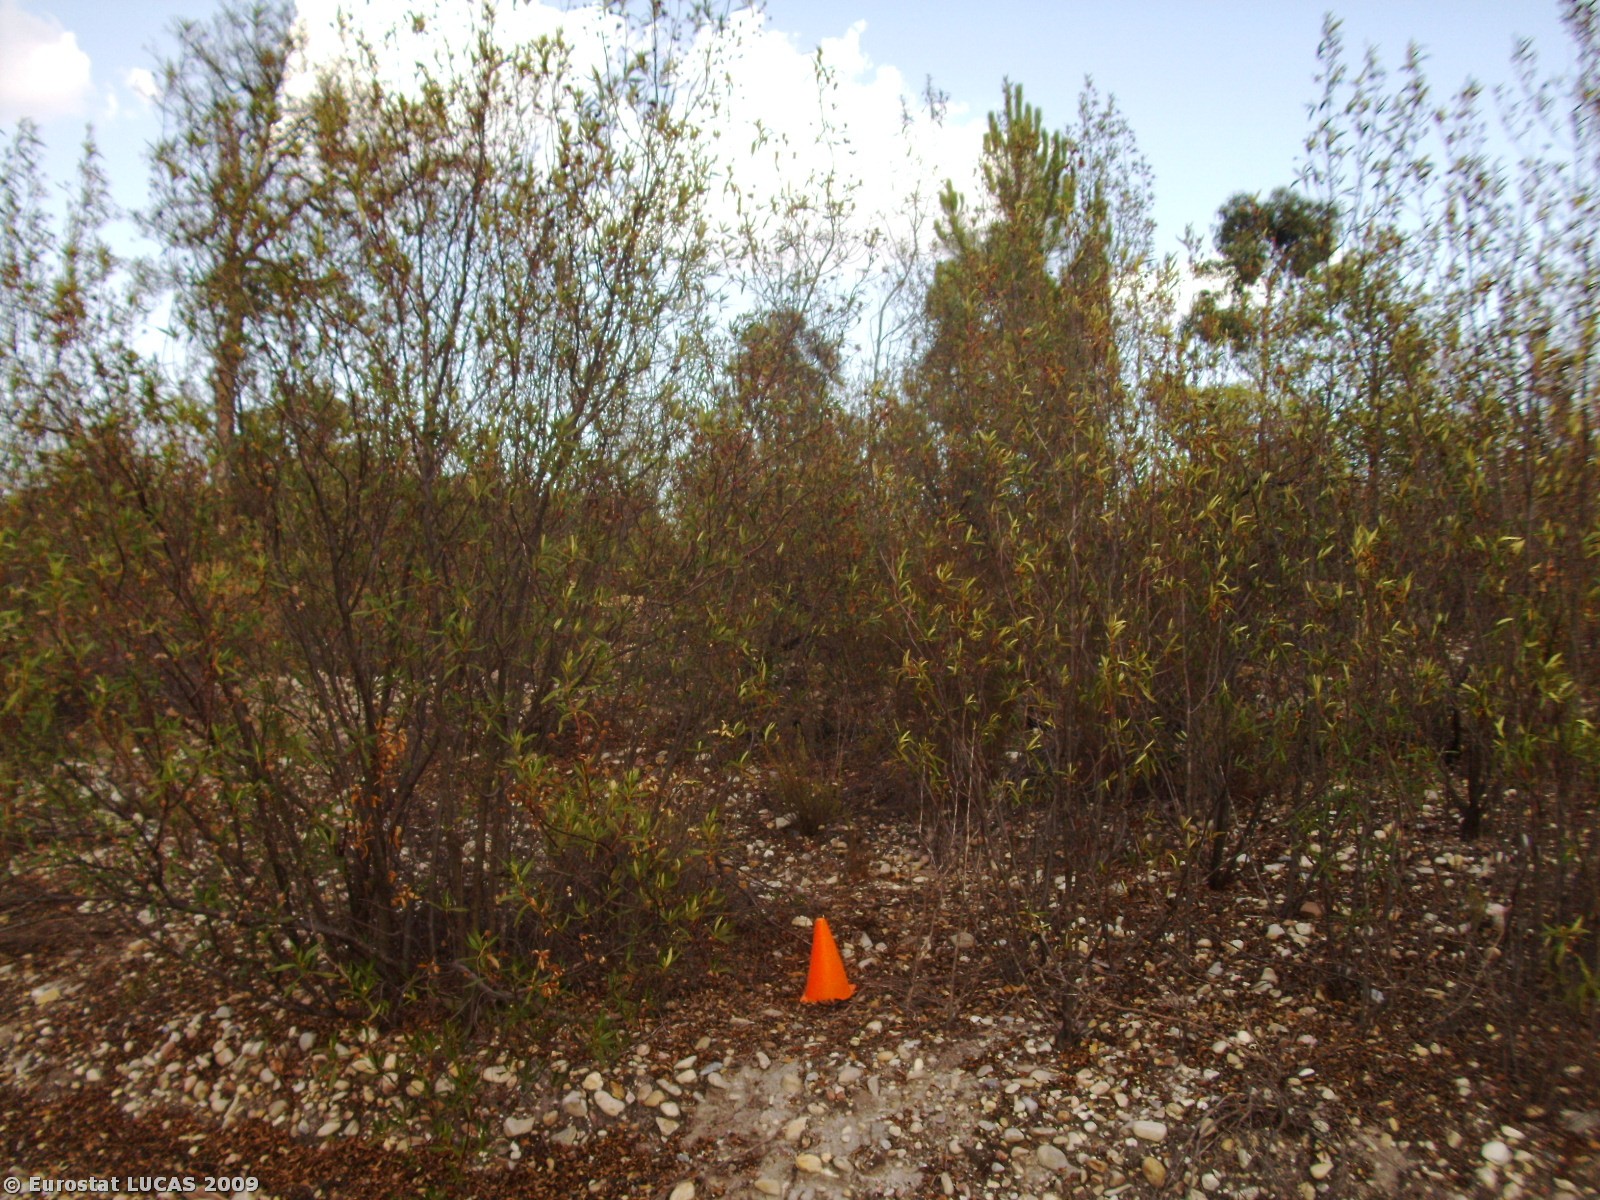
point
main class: Woodland
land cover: Broadleaved woodland
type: broadleaved evergreen forest
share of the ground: 25 - 50 %
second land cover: Shrubland with sparse tree cover
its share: 25 - 50 %
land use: Forestry
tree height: > 5 m
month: August
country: PT
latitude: 39.1904
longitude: -8.0347
